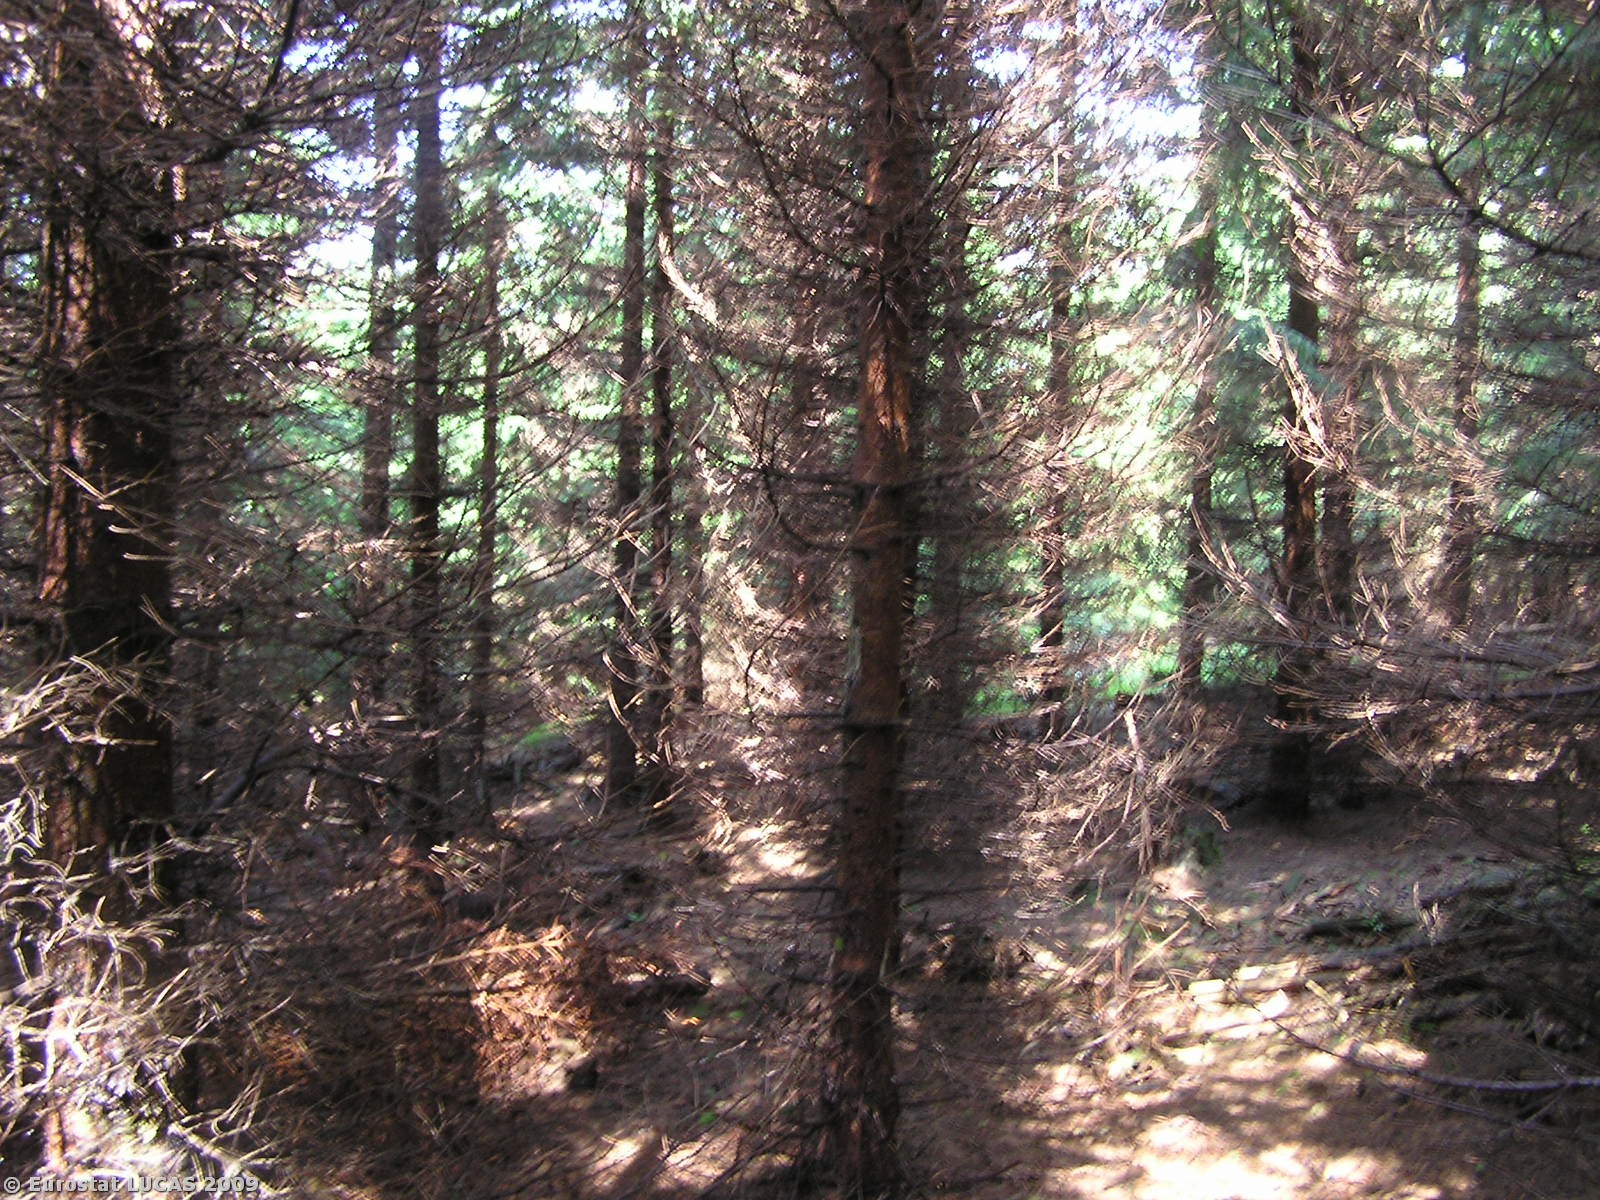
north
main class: Woodland
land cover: Coniferous woodland
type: hemiboreal forest and nemoral coniferous forest and mixed broadleaved-coniferous forest
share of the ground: > 75 %
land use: Forestry
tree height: > 5 m
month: June
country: CZ
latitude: 50.2110
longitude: 17.4530
